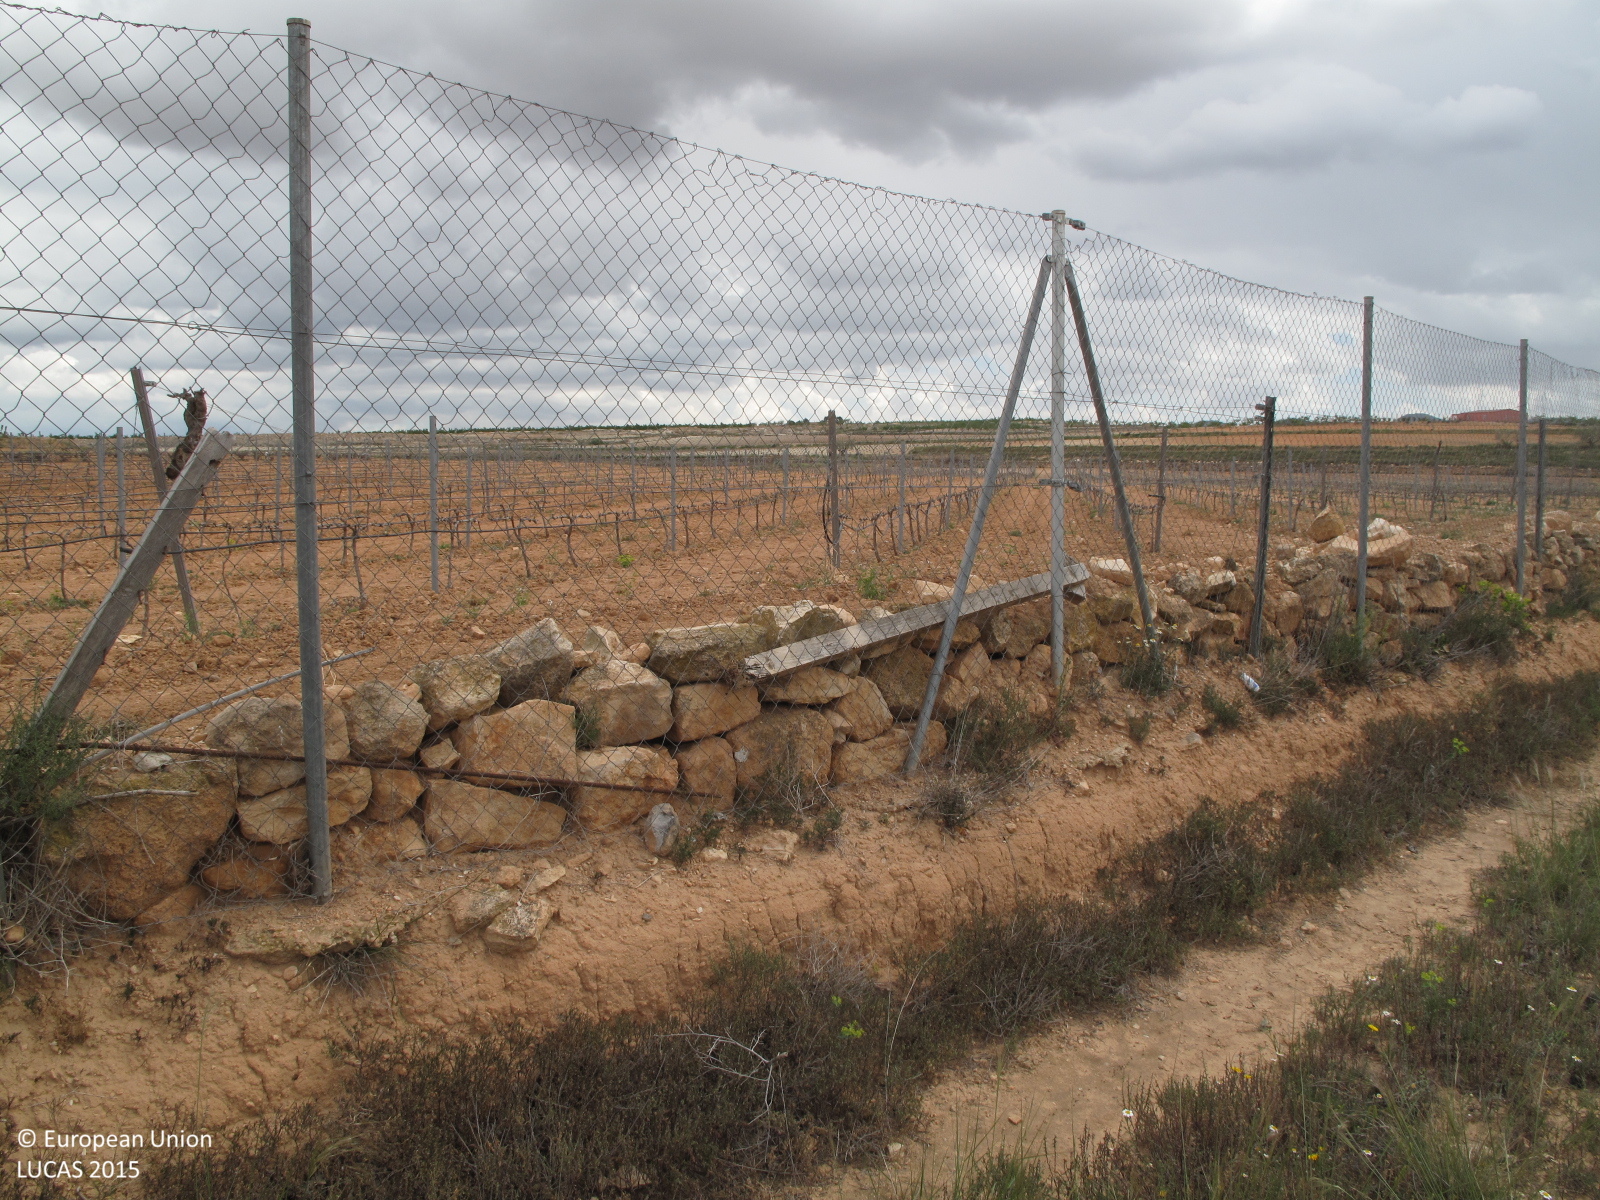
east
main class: Cropland
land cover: Vineyards
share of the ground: < 10 %
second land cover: Other bare soil
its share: > 75 %
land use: Agriculture (excluding fallow land and kitchen gardens)
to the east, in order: Grass margins; Tracks; Fences; Vineyards; Other bare soil; Tracks; Vineyards
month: April
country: ES
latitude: 38.4367
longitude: -1.0442
